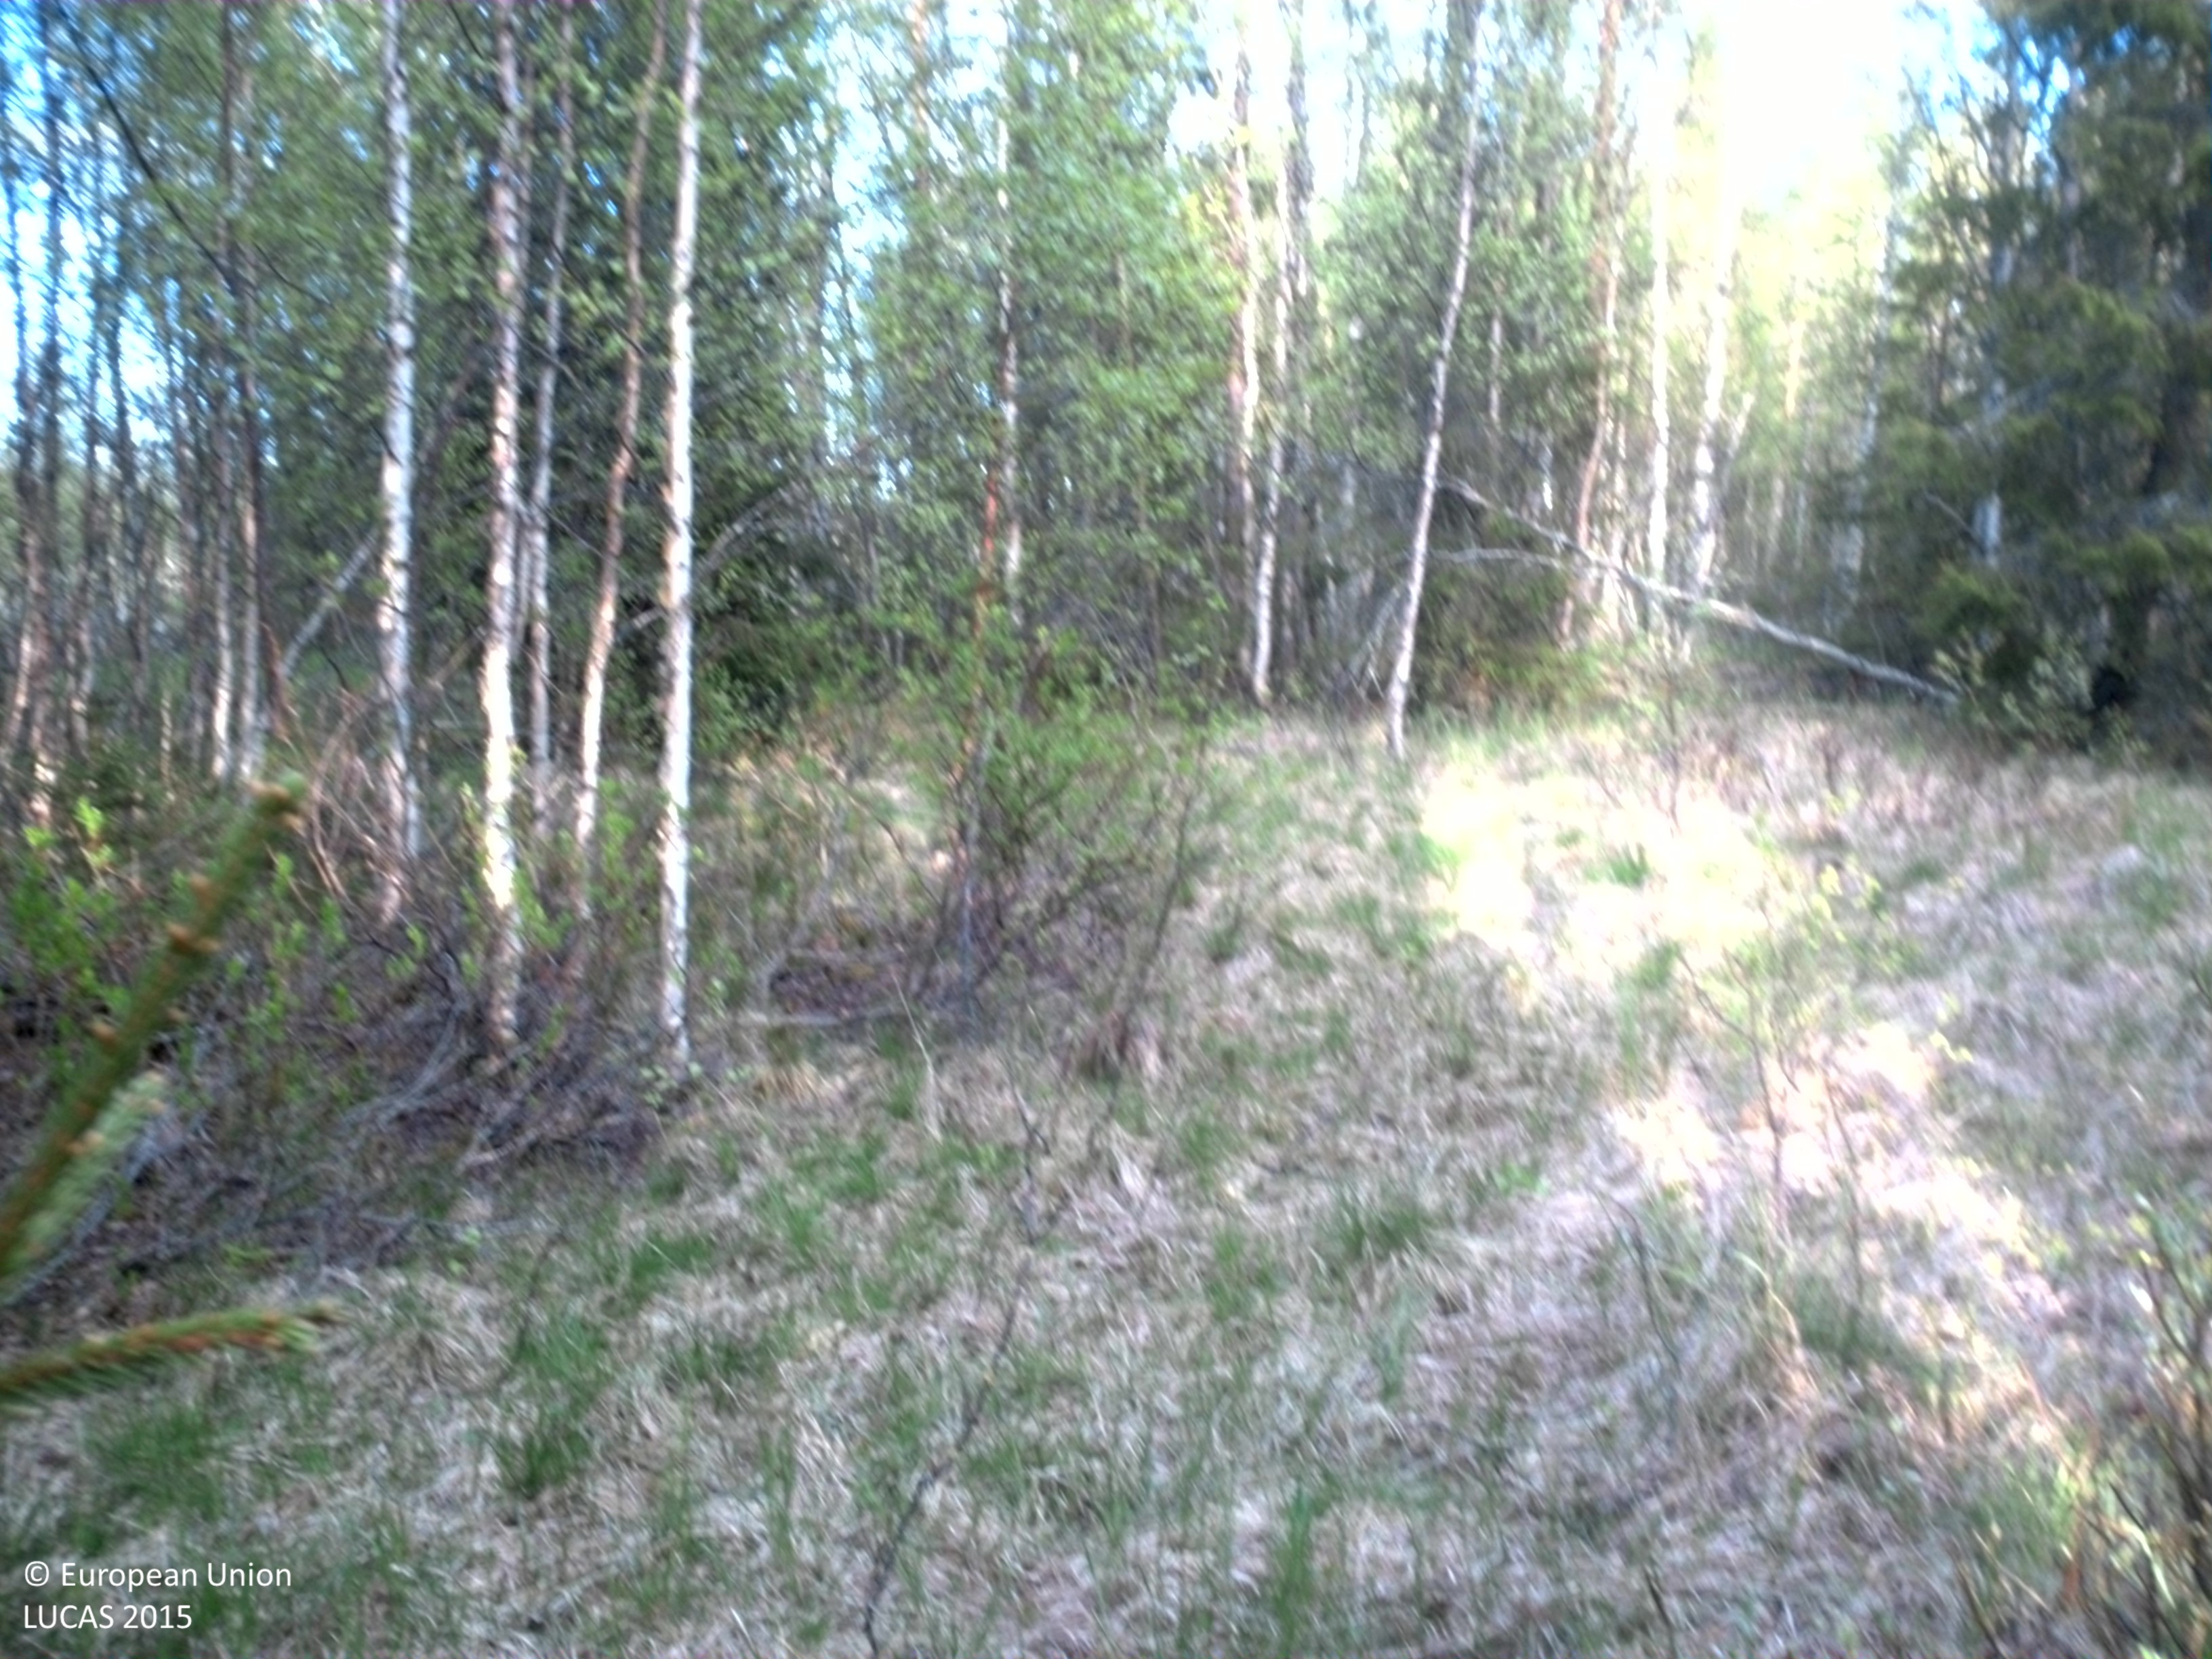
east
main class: Woodland
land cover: Other mixed woodland
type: boreal forest
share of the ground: 25 - 50 %
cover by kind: herbaceous plants 35 %, broadleaved forest trees 30 %, shrubs 20 %, coniferous forest trees 10 %
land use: Forestry
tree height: > 5 m
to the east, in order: Other mixed woodland; Grassland with sparse tree/shrub cover; Other mixed woodland; Ditches and canals; Broadleaved woodland; Shrubland with sparse tree cover; Rivers and streams; Shrubland with sparse tree cover; Grassland with sparse tree/shrub cover; Inland marshes
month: June
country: SE
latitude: 64.2212
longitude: 17.4914
